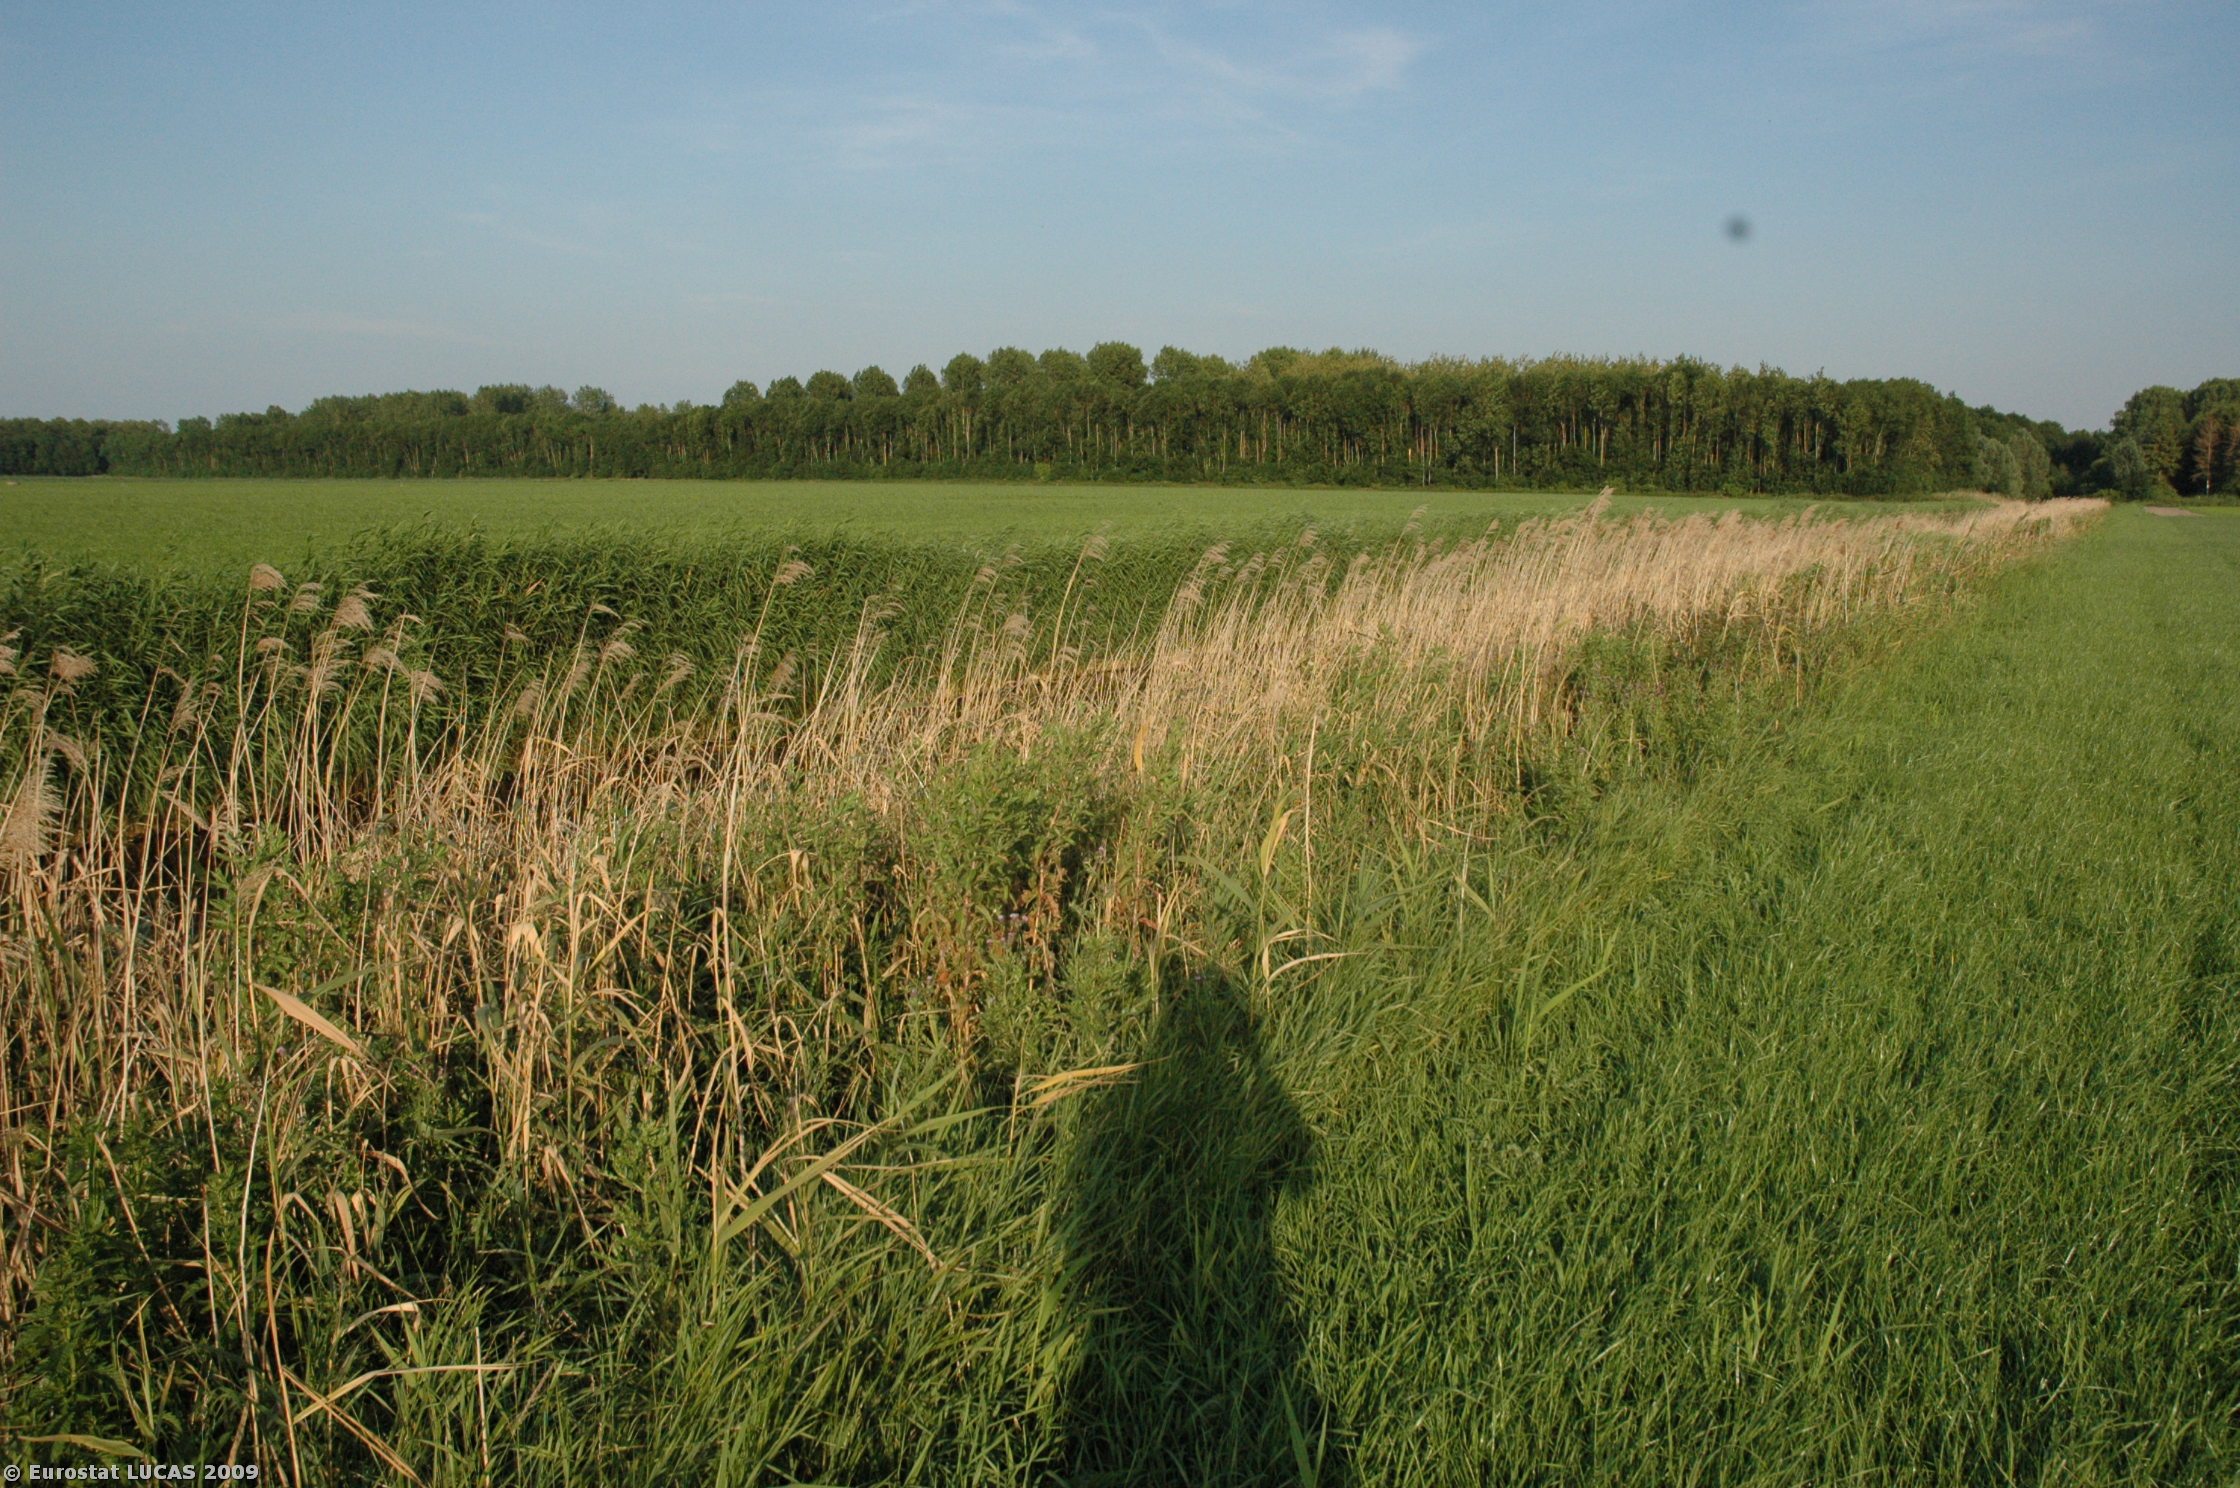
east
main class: Grassland
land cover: Grassland without tree/shrub cover
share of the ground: > 75 %
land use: Agriculture (excluding fallow land and kitchen gardens)
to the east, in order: Grassland without tree/shrub cover; Shruby margins; Inland running water; Shruby margins; Grassland without tree/shrub cover
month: June
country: NL
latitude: 52.2708
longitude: 5.4113
